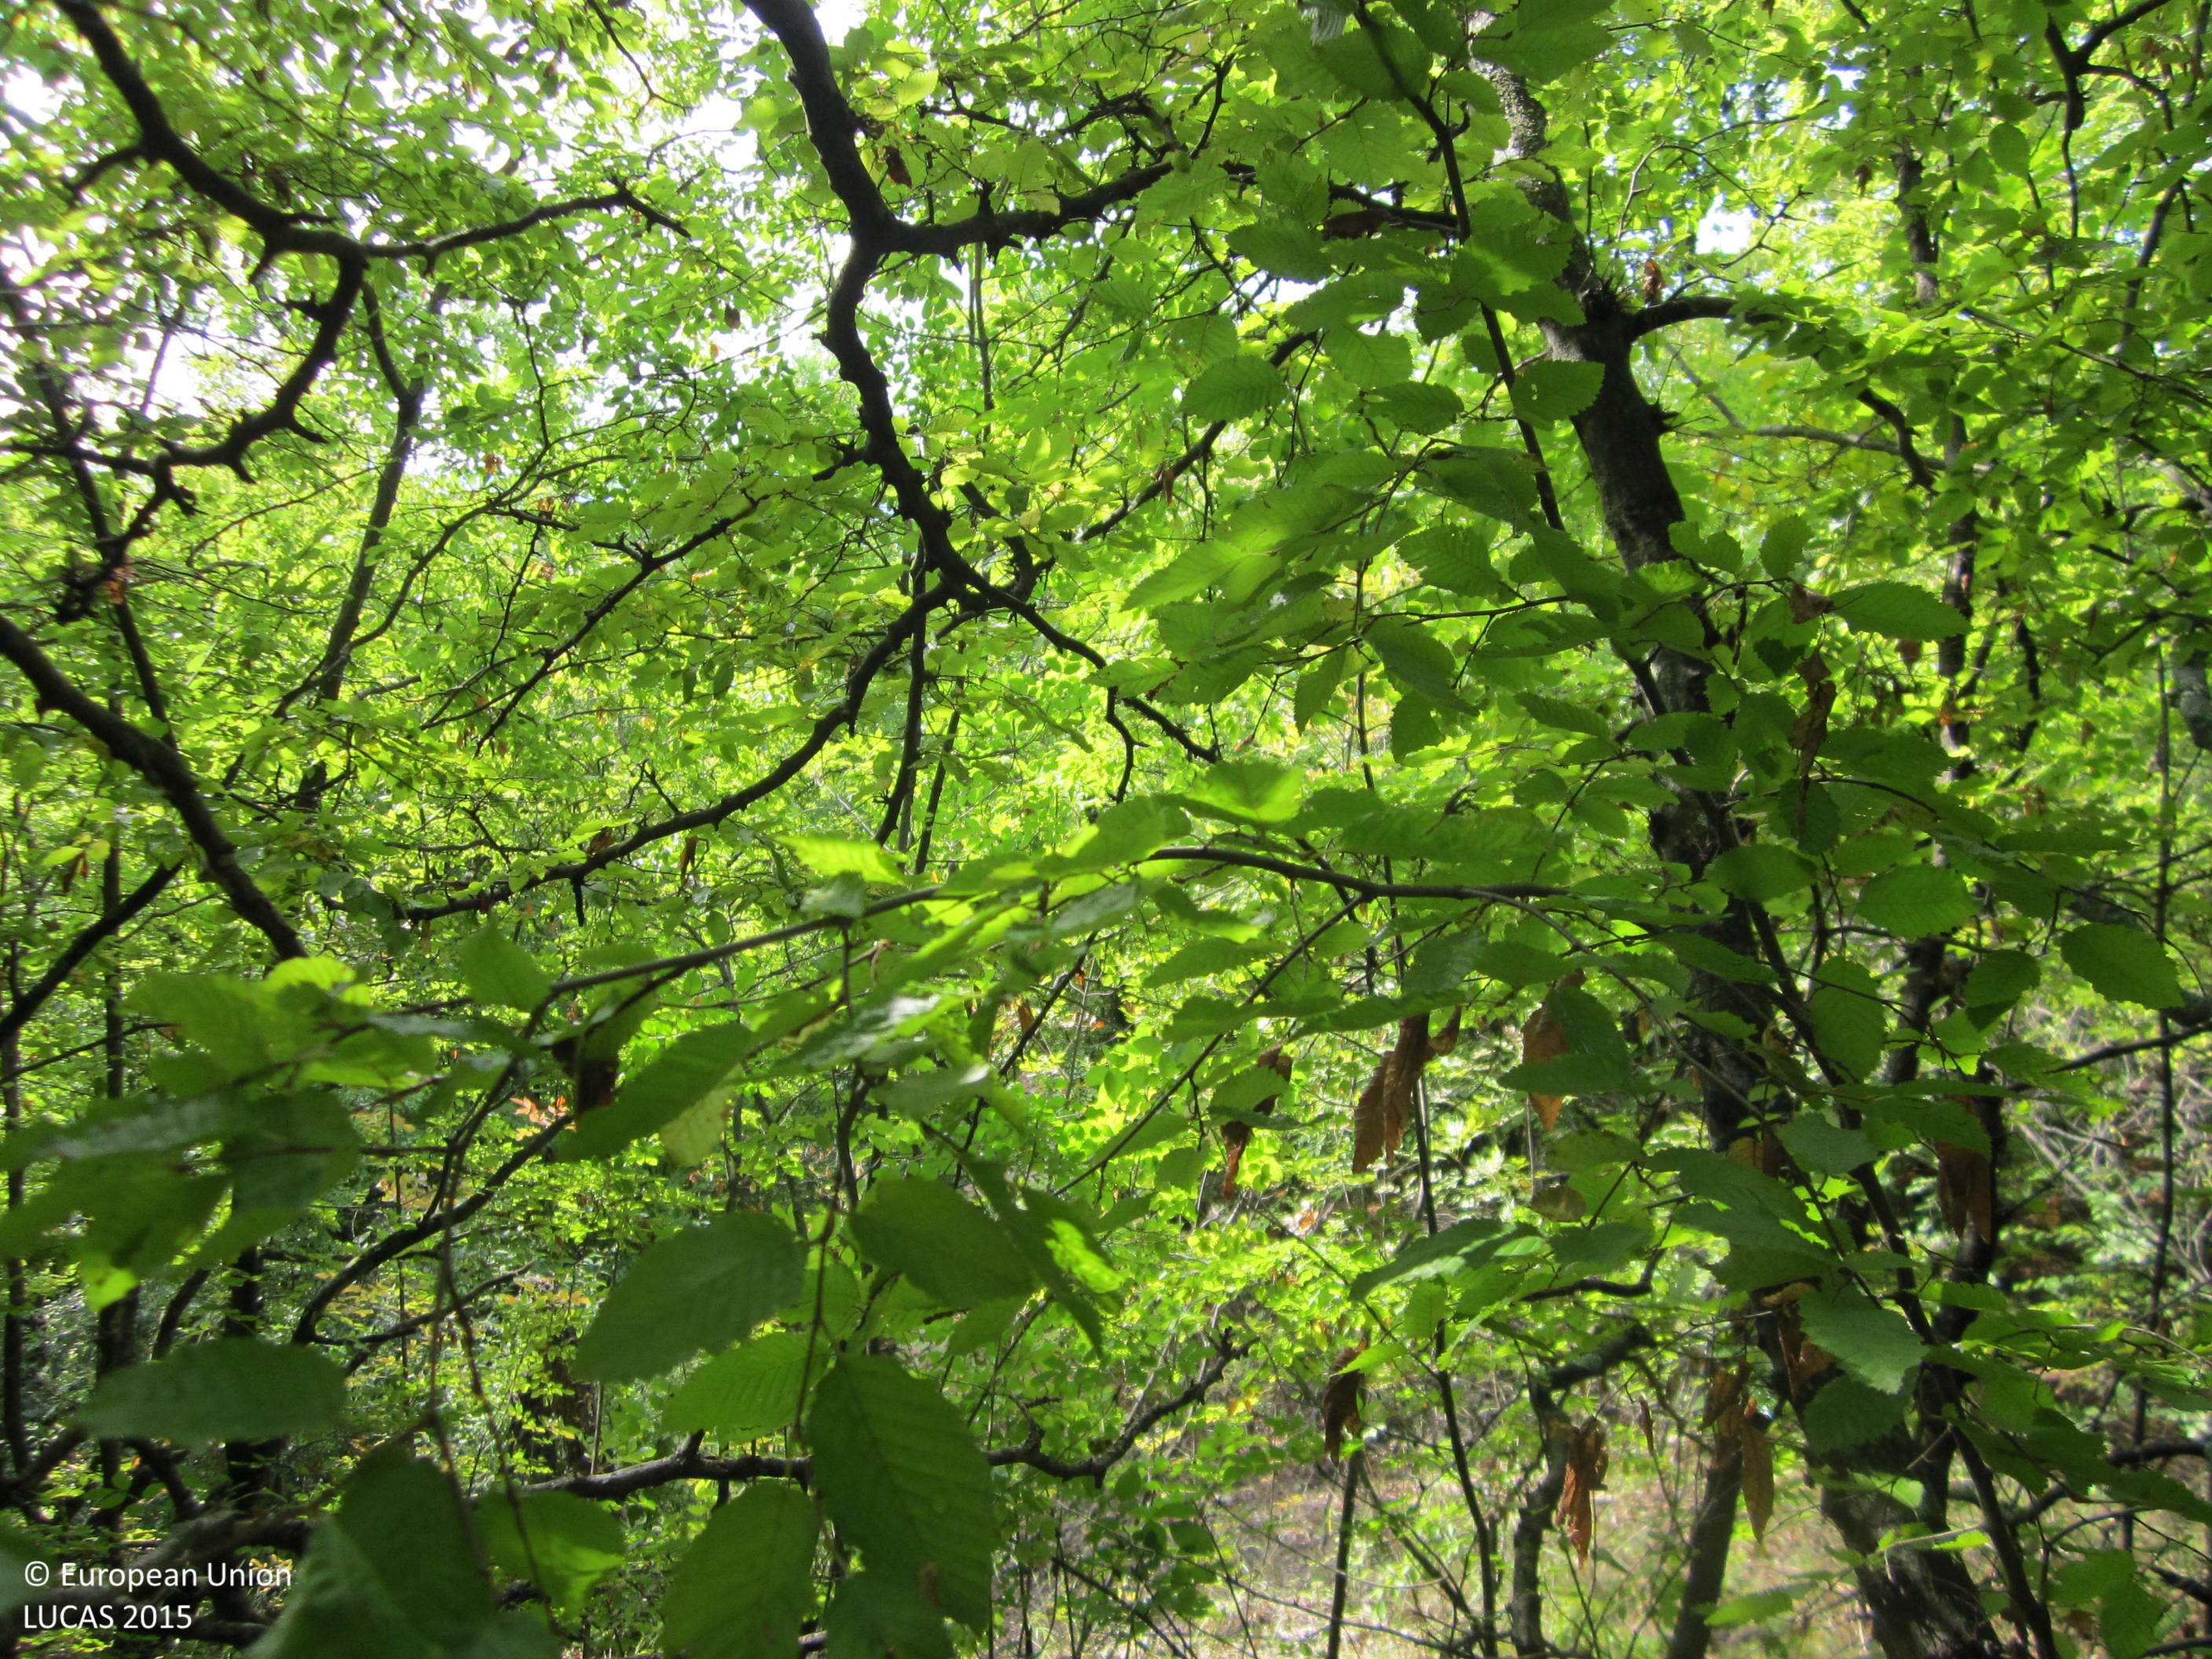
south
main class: Woodland
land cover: Broadleaved woodland
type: acidophilous oak and oak-birch forest
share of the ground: 50 - 75 %
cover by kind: broadleaved forest trees 70 %, unconsolidated bare surface 15 %, herbaceous plants 10 %, shrubs 5 %
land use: Forestry
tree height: > 5 m
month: October
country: BG
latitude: 42.7636
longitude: 26.7077
